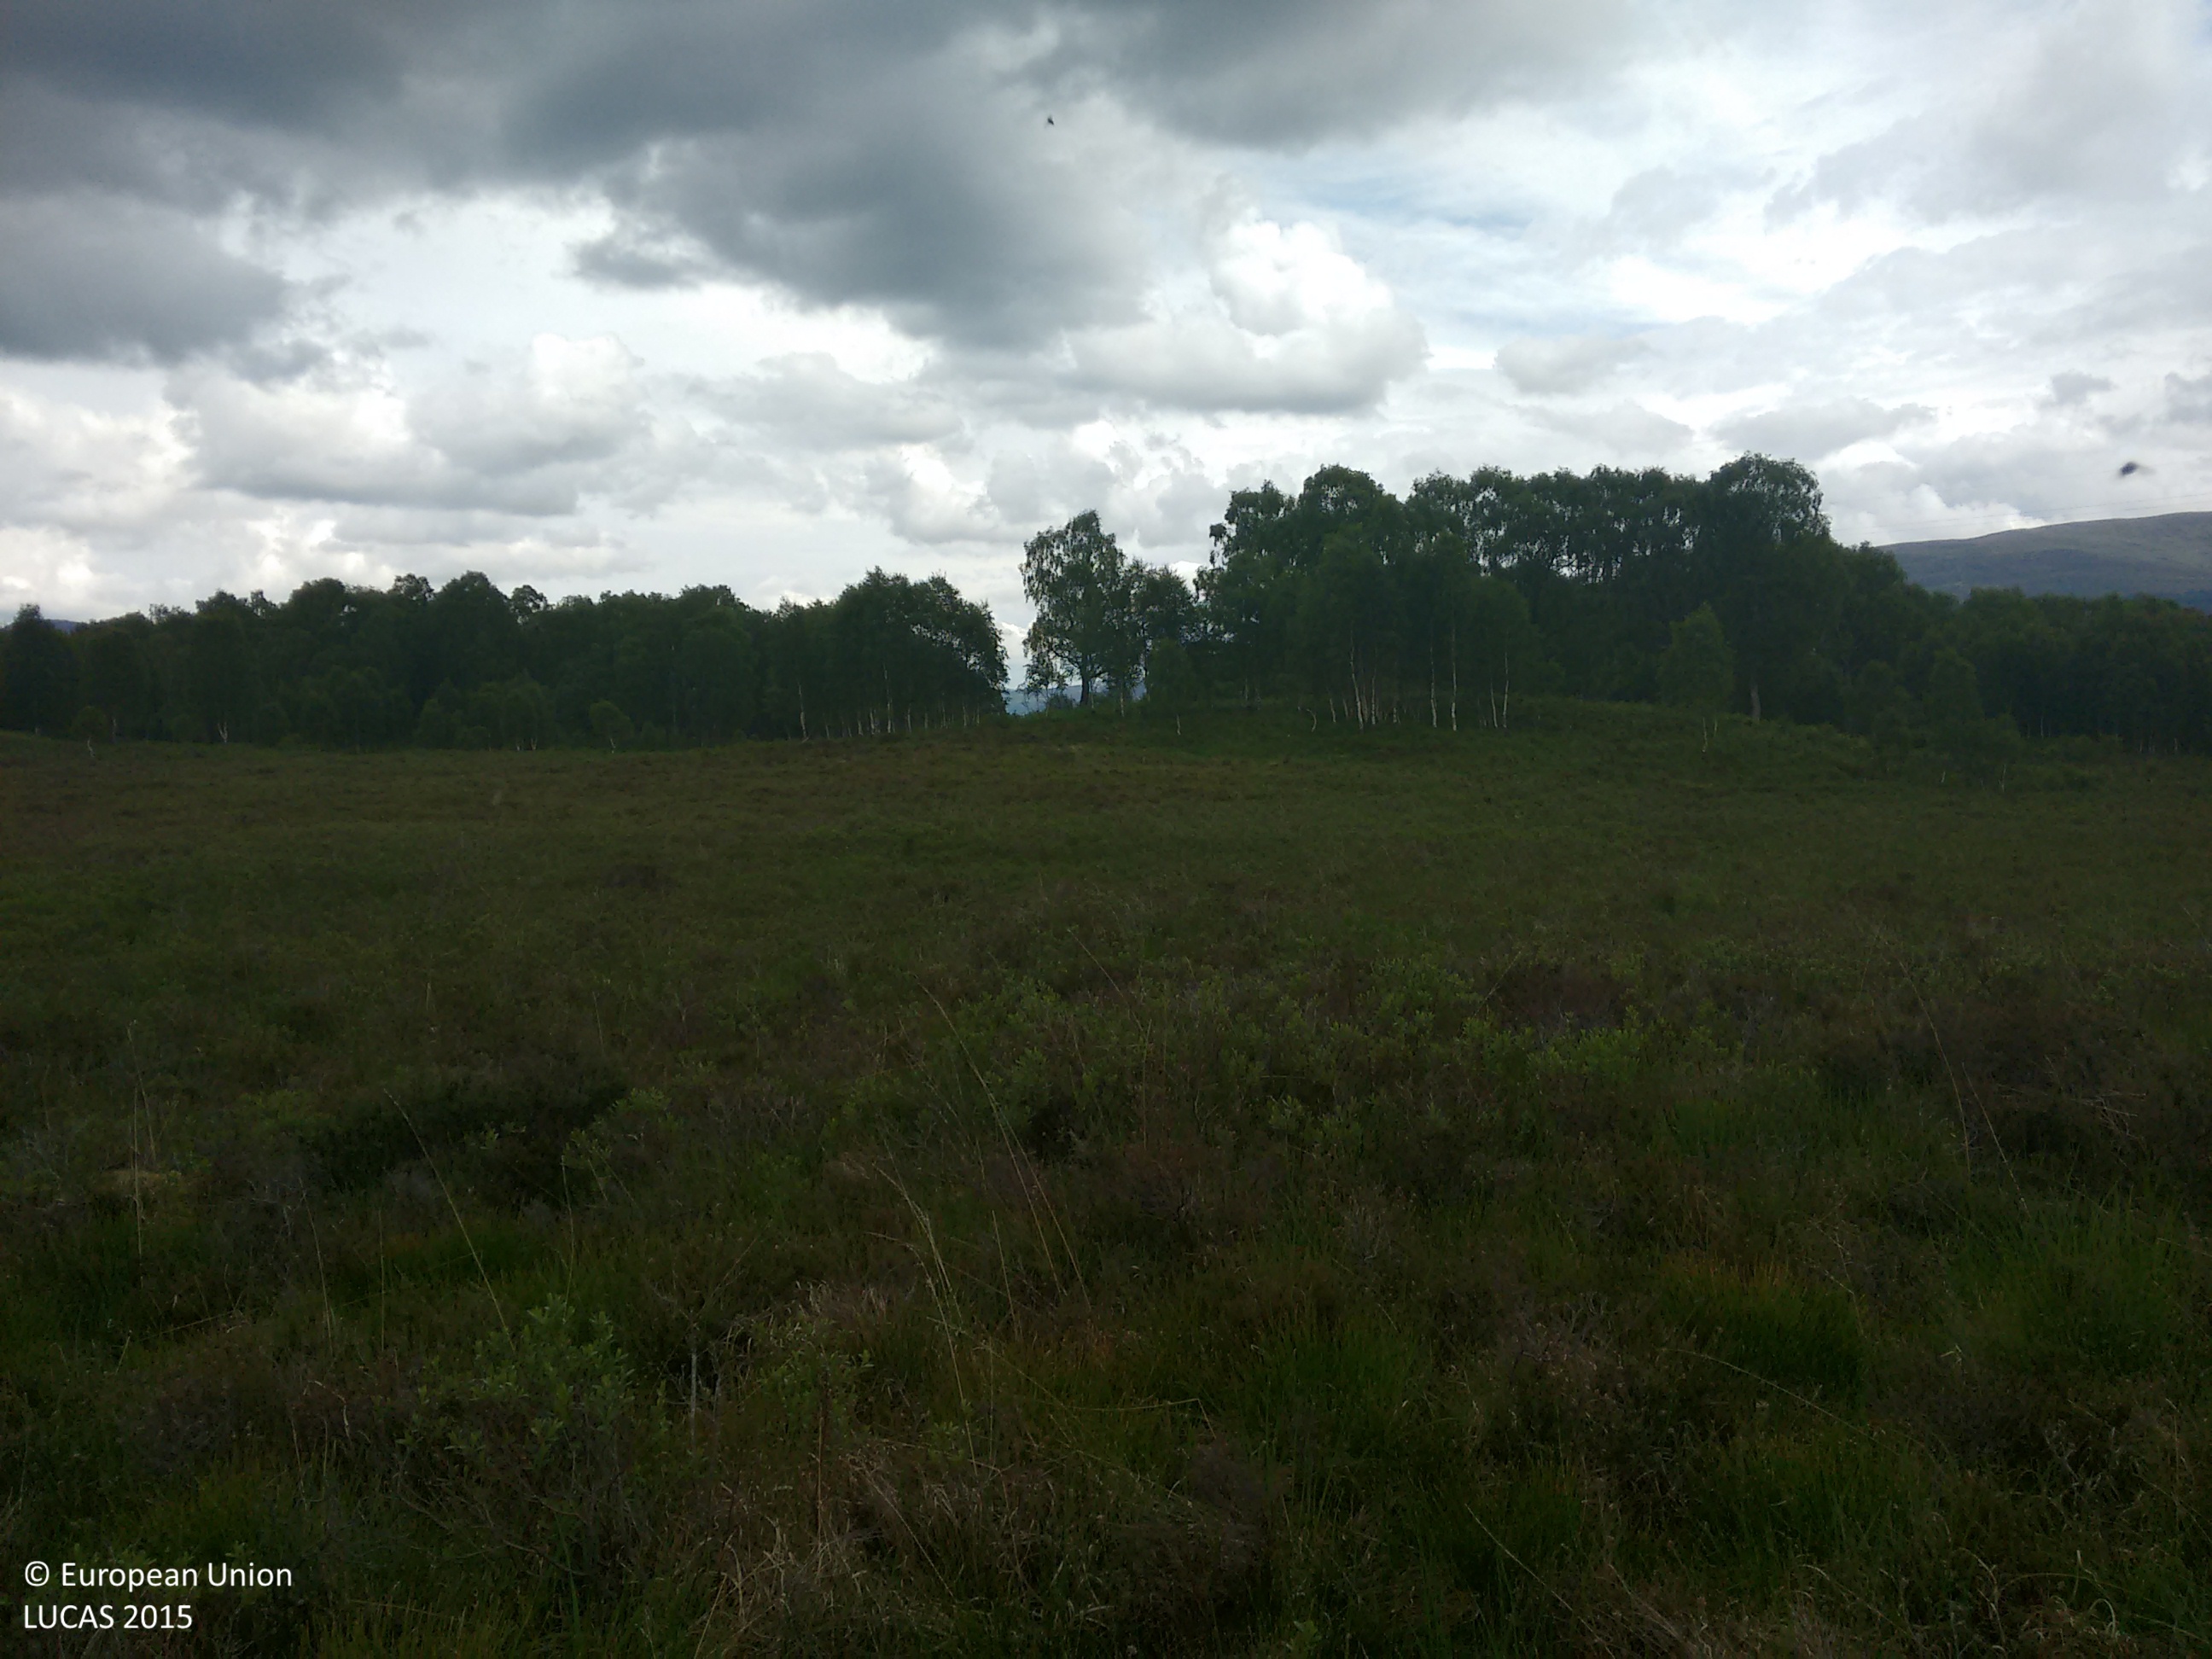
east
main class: Shrubland
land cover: Shrubland without tree cover
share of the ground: > 75 %
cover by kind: shrubs 65 %, herbaceous plants 25 %, lichens and mosses 10 %
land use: Semi-natural and natural areas not in use
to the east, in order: Shrubland without tree cover; Peatbogs; Broadleaved woodland; Peatbogs; Broadleaved woodland
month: July
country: GB
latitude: 56.6969
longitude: -4.3145
